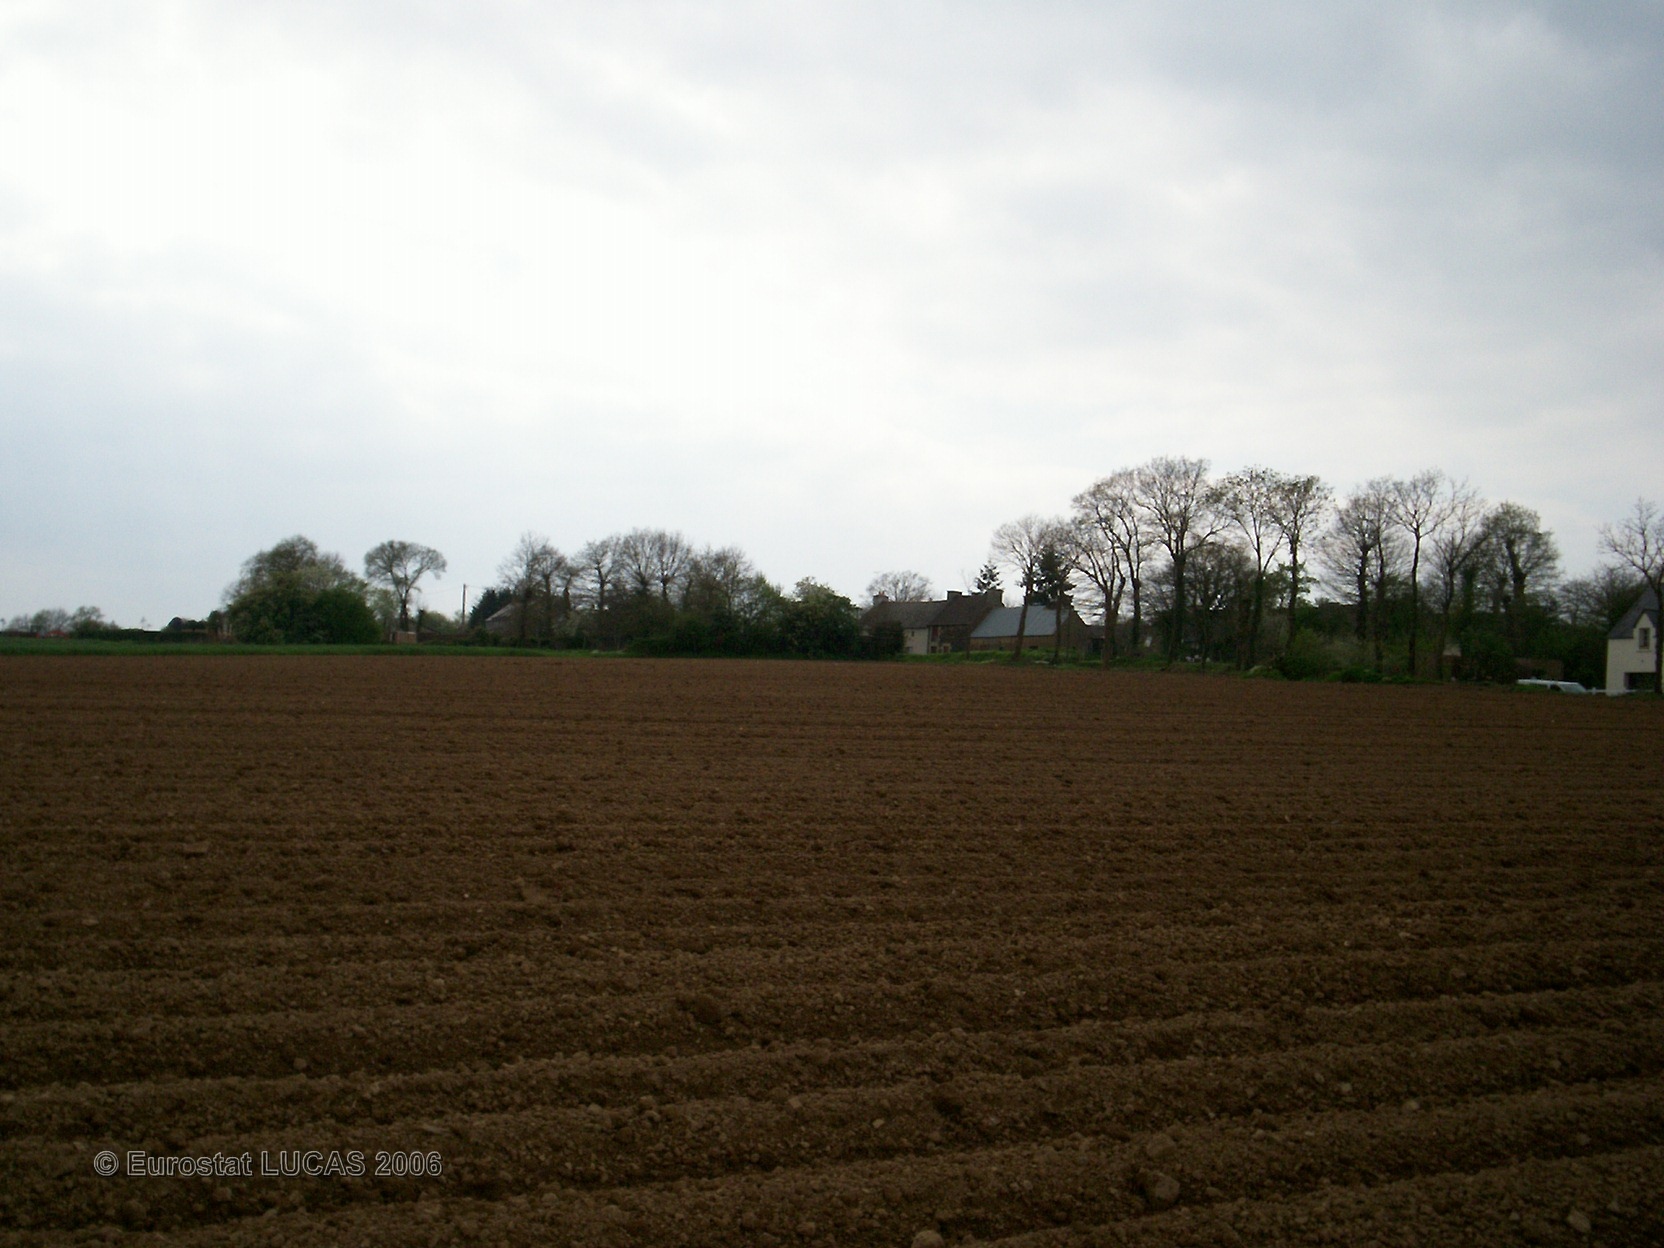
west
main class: Cropland
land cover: Maize
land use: Agriculture (excluding fallow land and kitchen gardens)
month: April
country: FR
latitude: 48.0112
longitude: -2.4046
